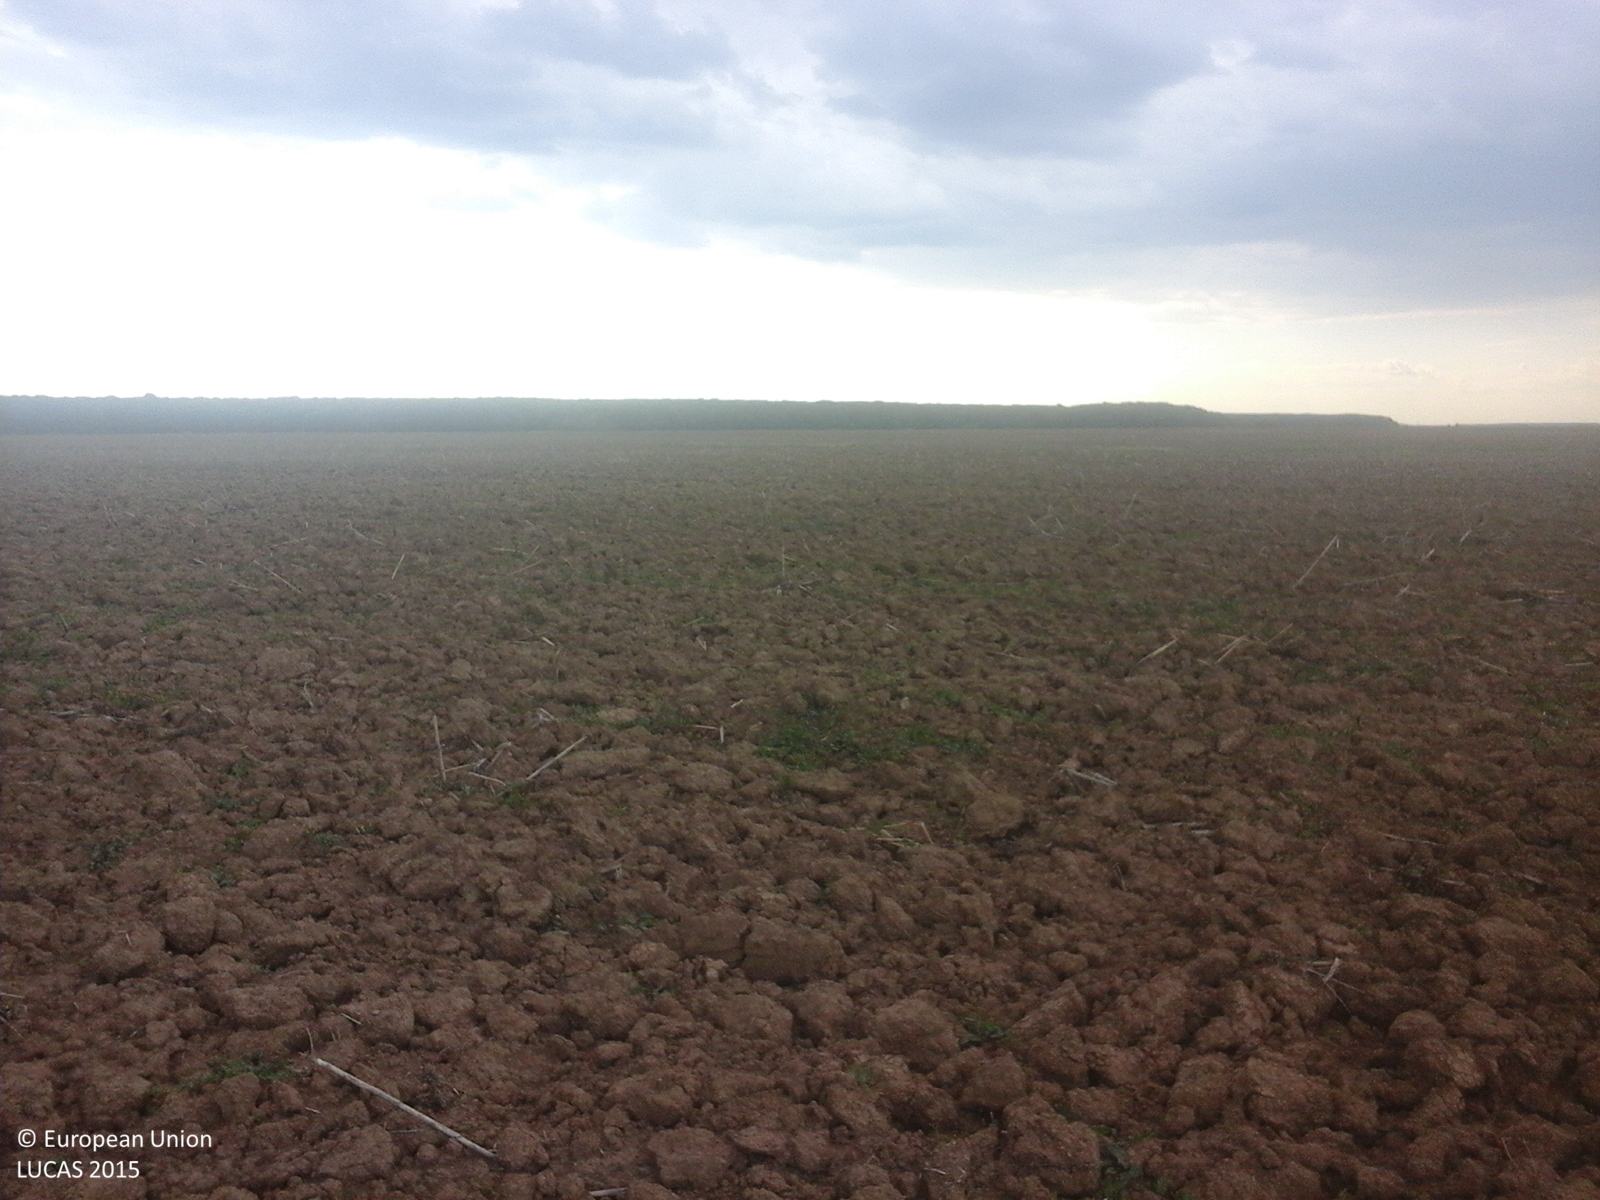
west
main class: Cropland
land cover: Other cereals
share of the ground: < 10 %
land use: Agriculture (excluding fallow land and kitchen gardens)
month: July
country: RO
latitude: 44.4805
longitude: 25.4931
